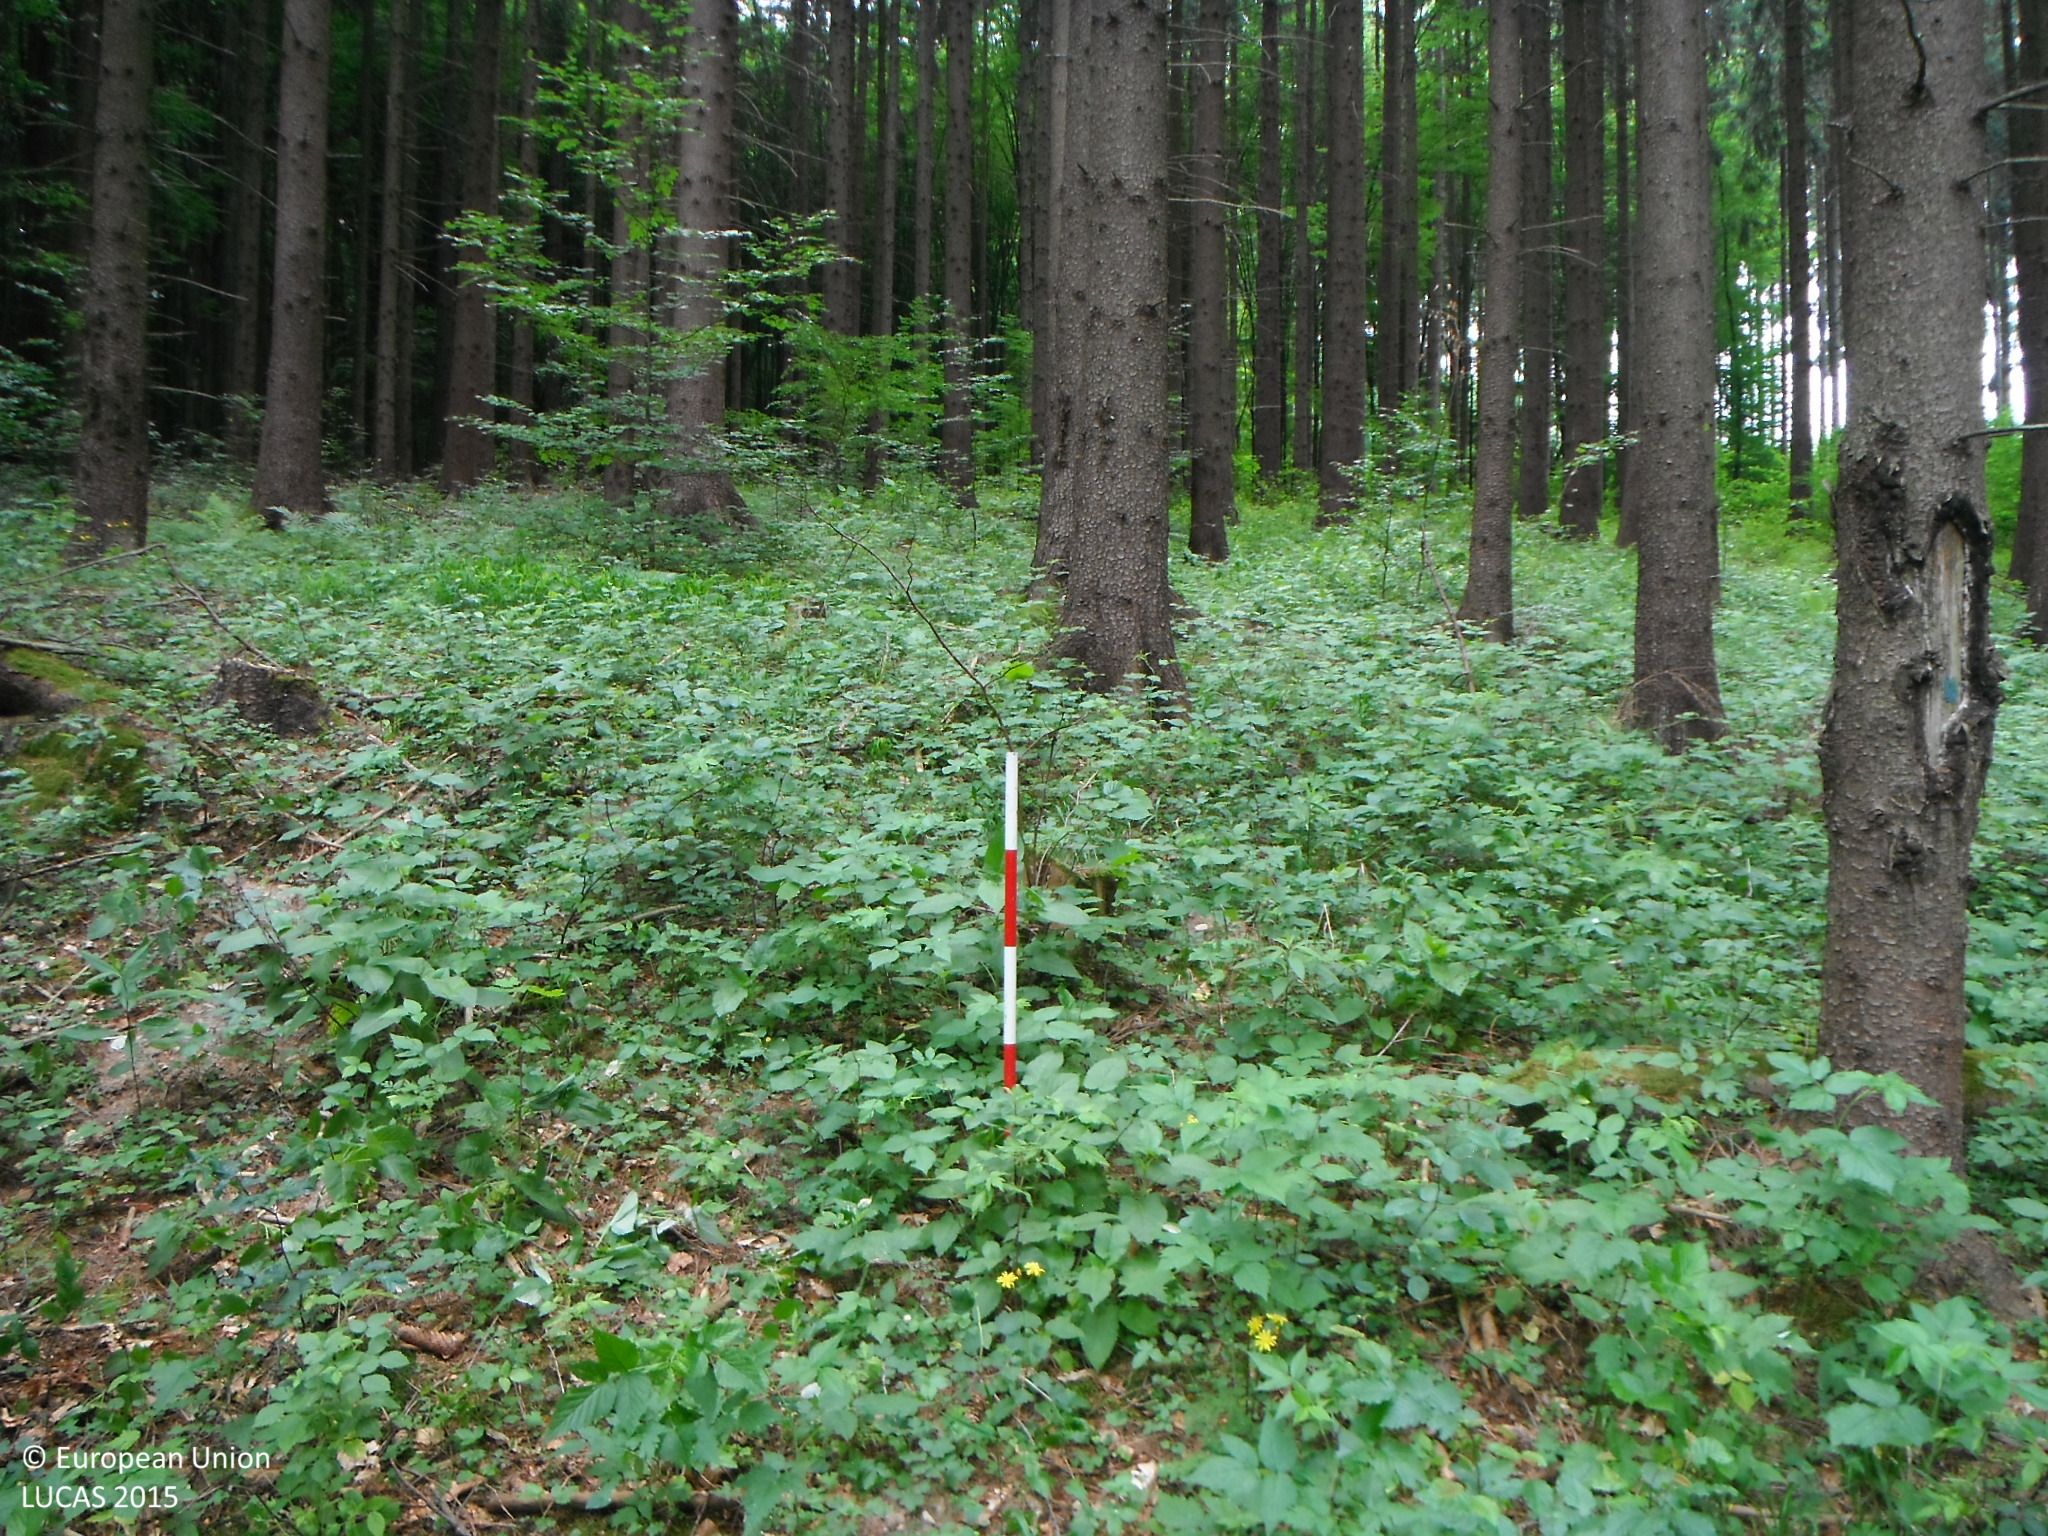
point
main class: Woodland
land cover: Spruce dominated coniferous woodland
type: alpine coniferous forest
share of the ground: > 75 %
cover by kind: coniferous forest trees 90 %, shrubs 5 %, herbaceous plants 5 %
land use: Forestry
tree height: > 5 m
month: June
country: SK
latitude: 48.6206
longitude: 19.3709
